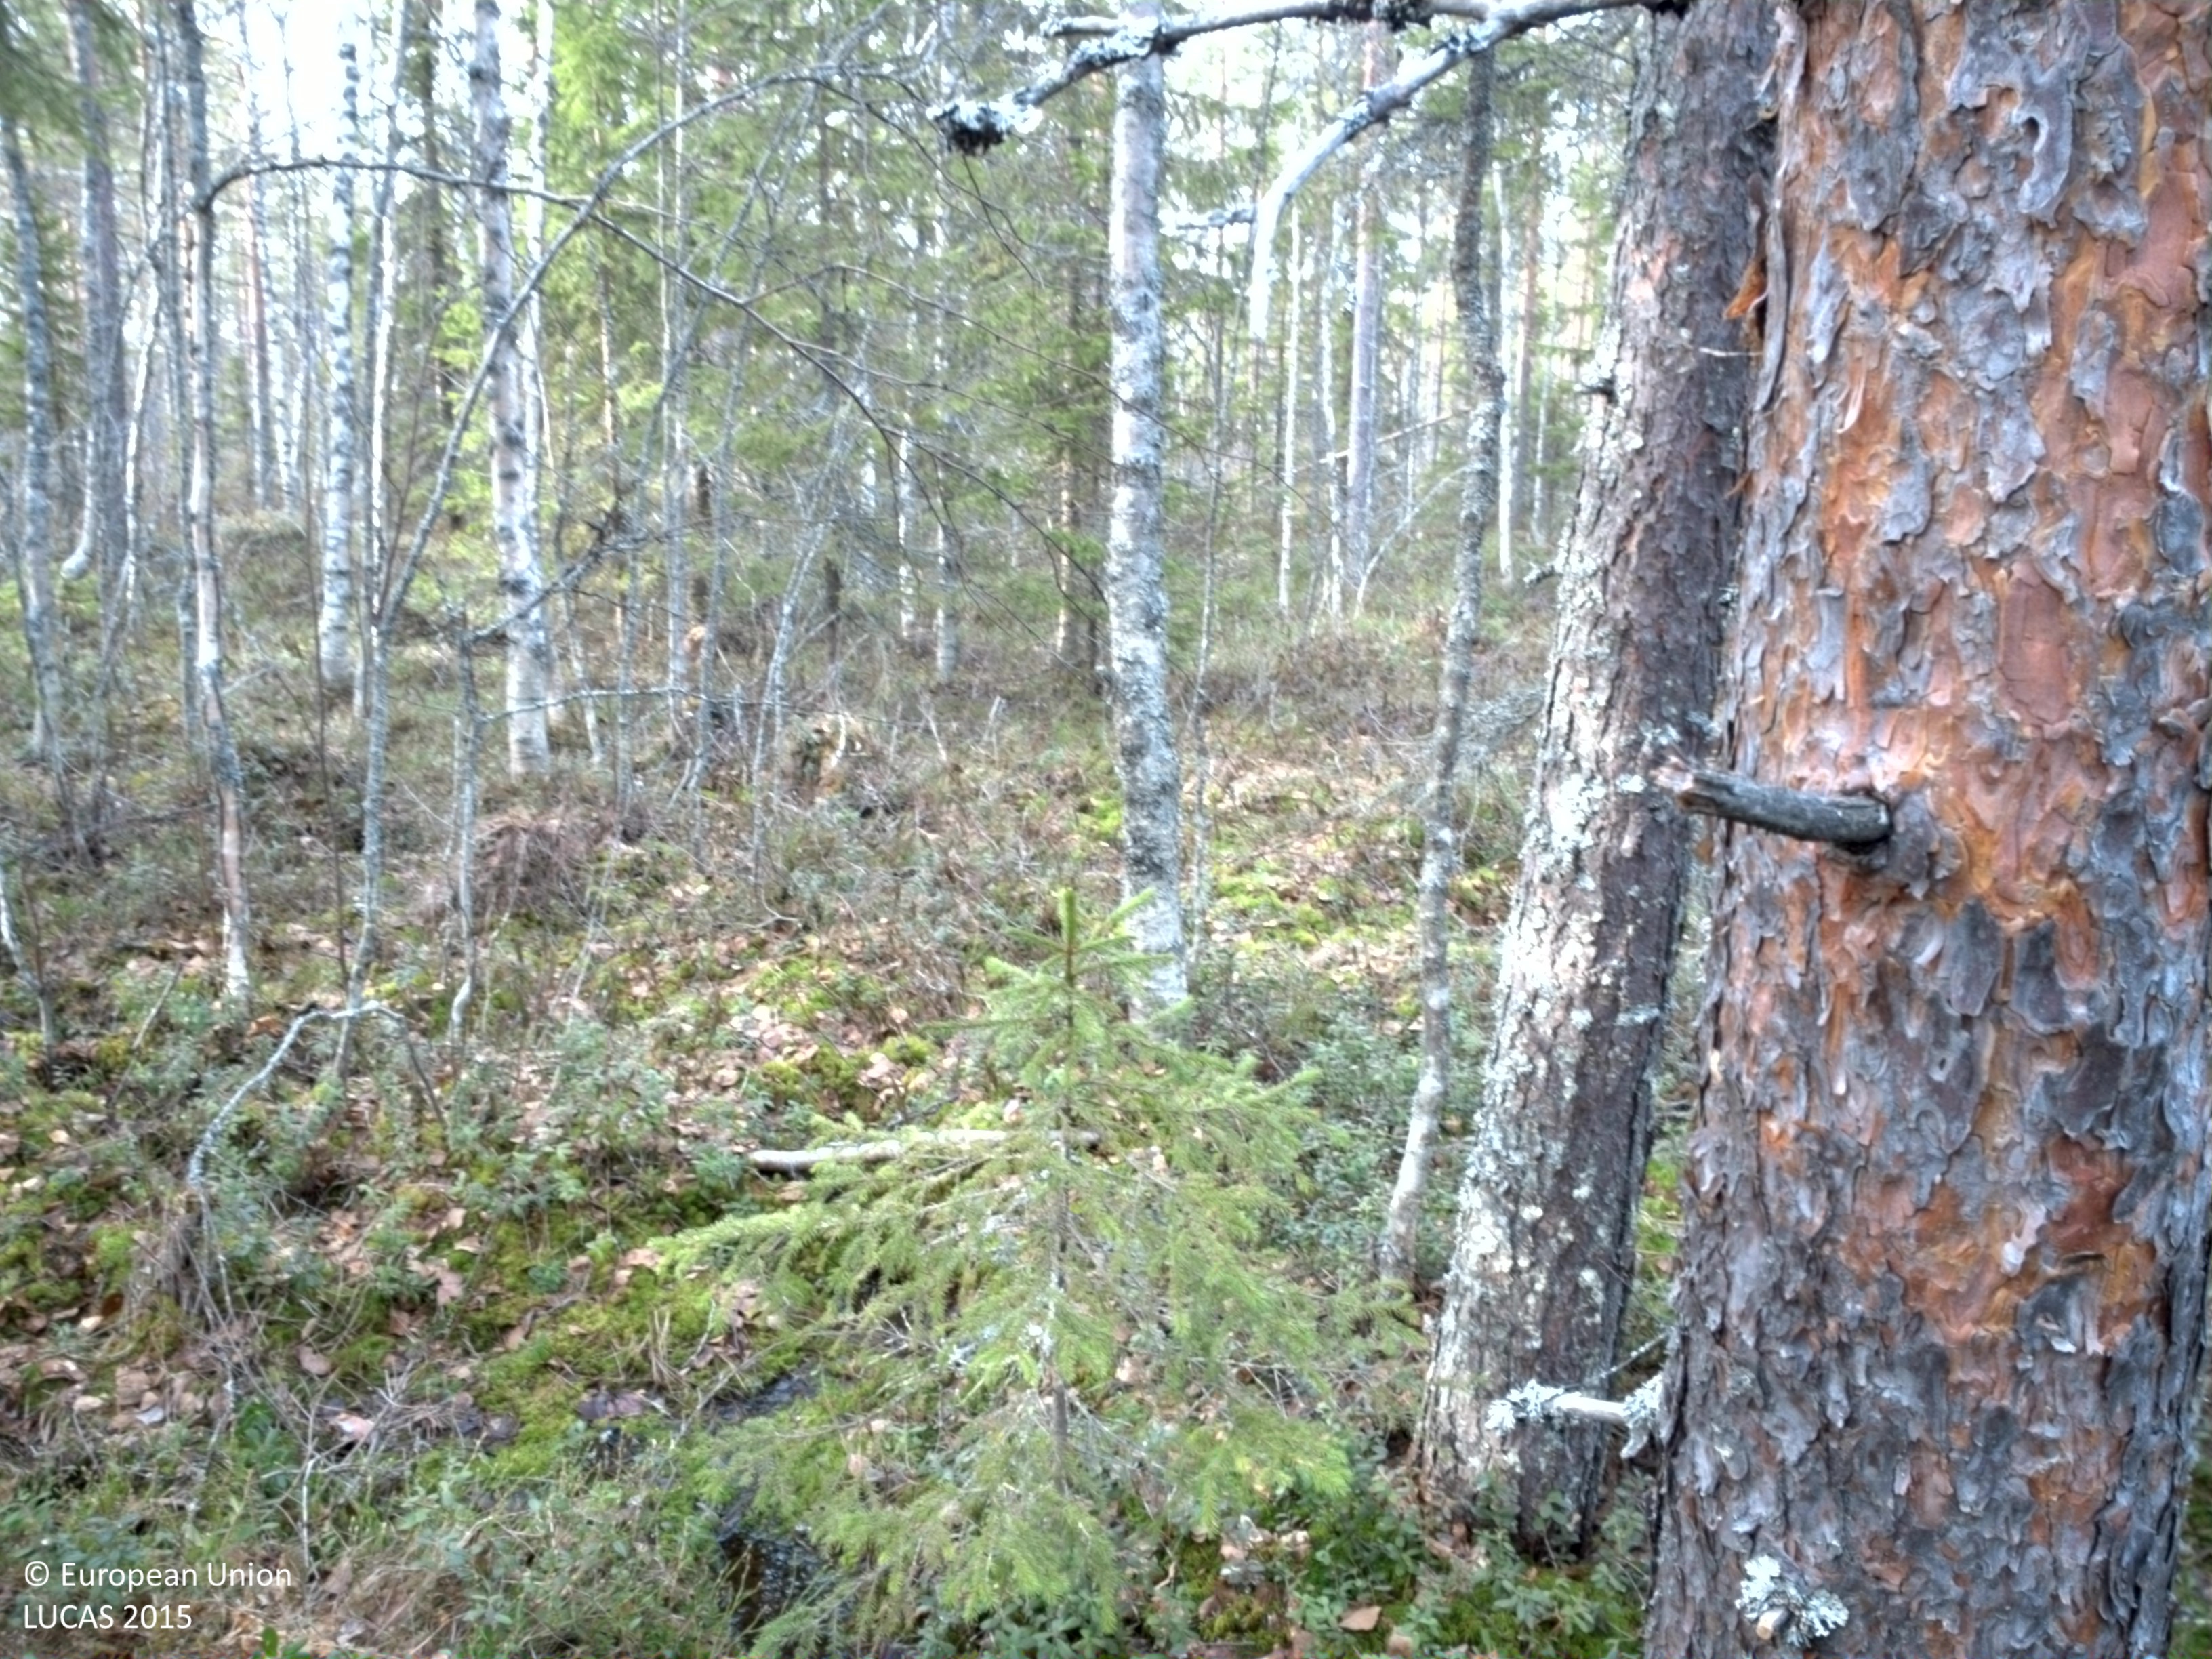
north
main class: Woodland
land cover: Pine dominated mixed woodland
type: mire and swamp forests
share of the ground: > 75 %
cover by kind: coniferous forest trees 65 %, broadleaved forest trees 25 %, shrubs 10 %
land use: Forestry
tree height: > 5 m
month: May
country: SE
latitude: 65.8484
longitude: 23.6409
